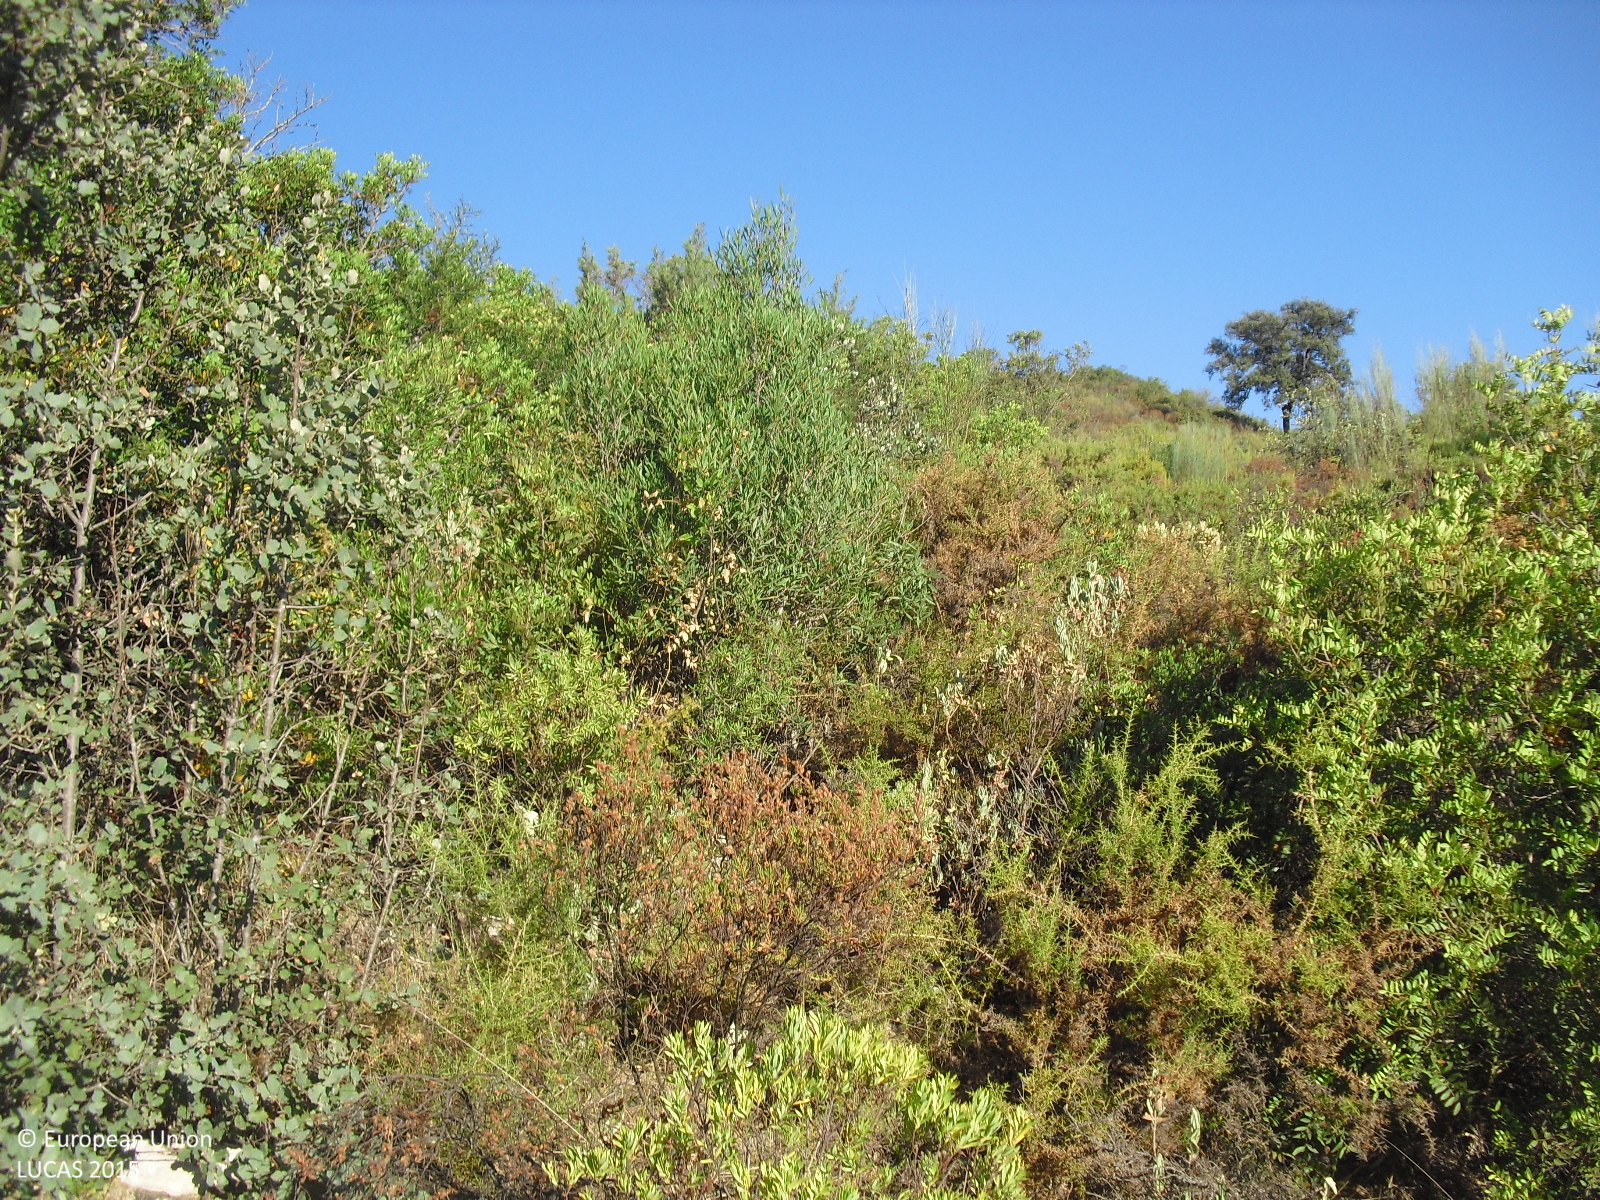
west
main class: Shrubland
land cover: Shrubland with sparse tree cover
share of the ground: 50 - 75 %
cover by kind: shrubs 50 %, herbaceous plants 45 %, broadleaved forest trees 5 %
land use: Agriculture (excluding fallow land and kitchen gardens)
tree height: < 5 m
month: July
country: ES
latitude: 36.9881
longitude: -5.3651
